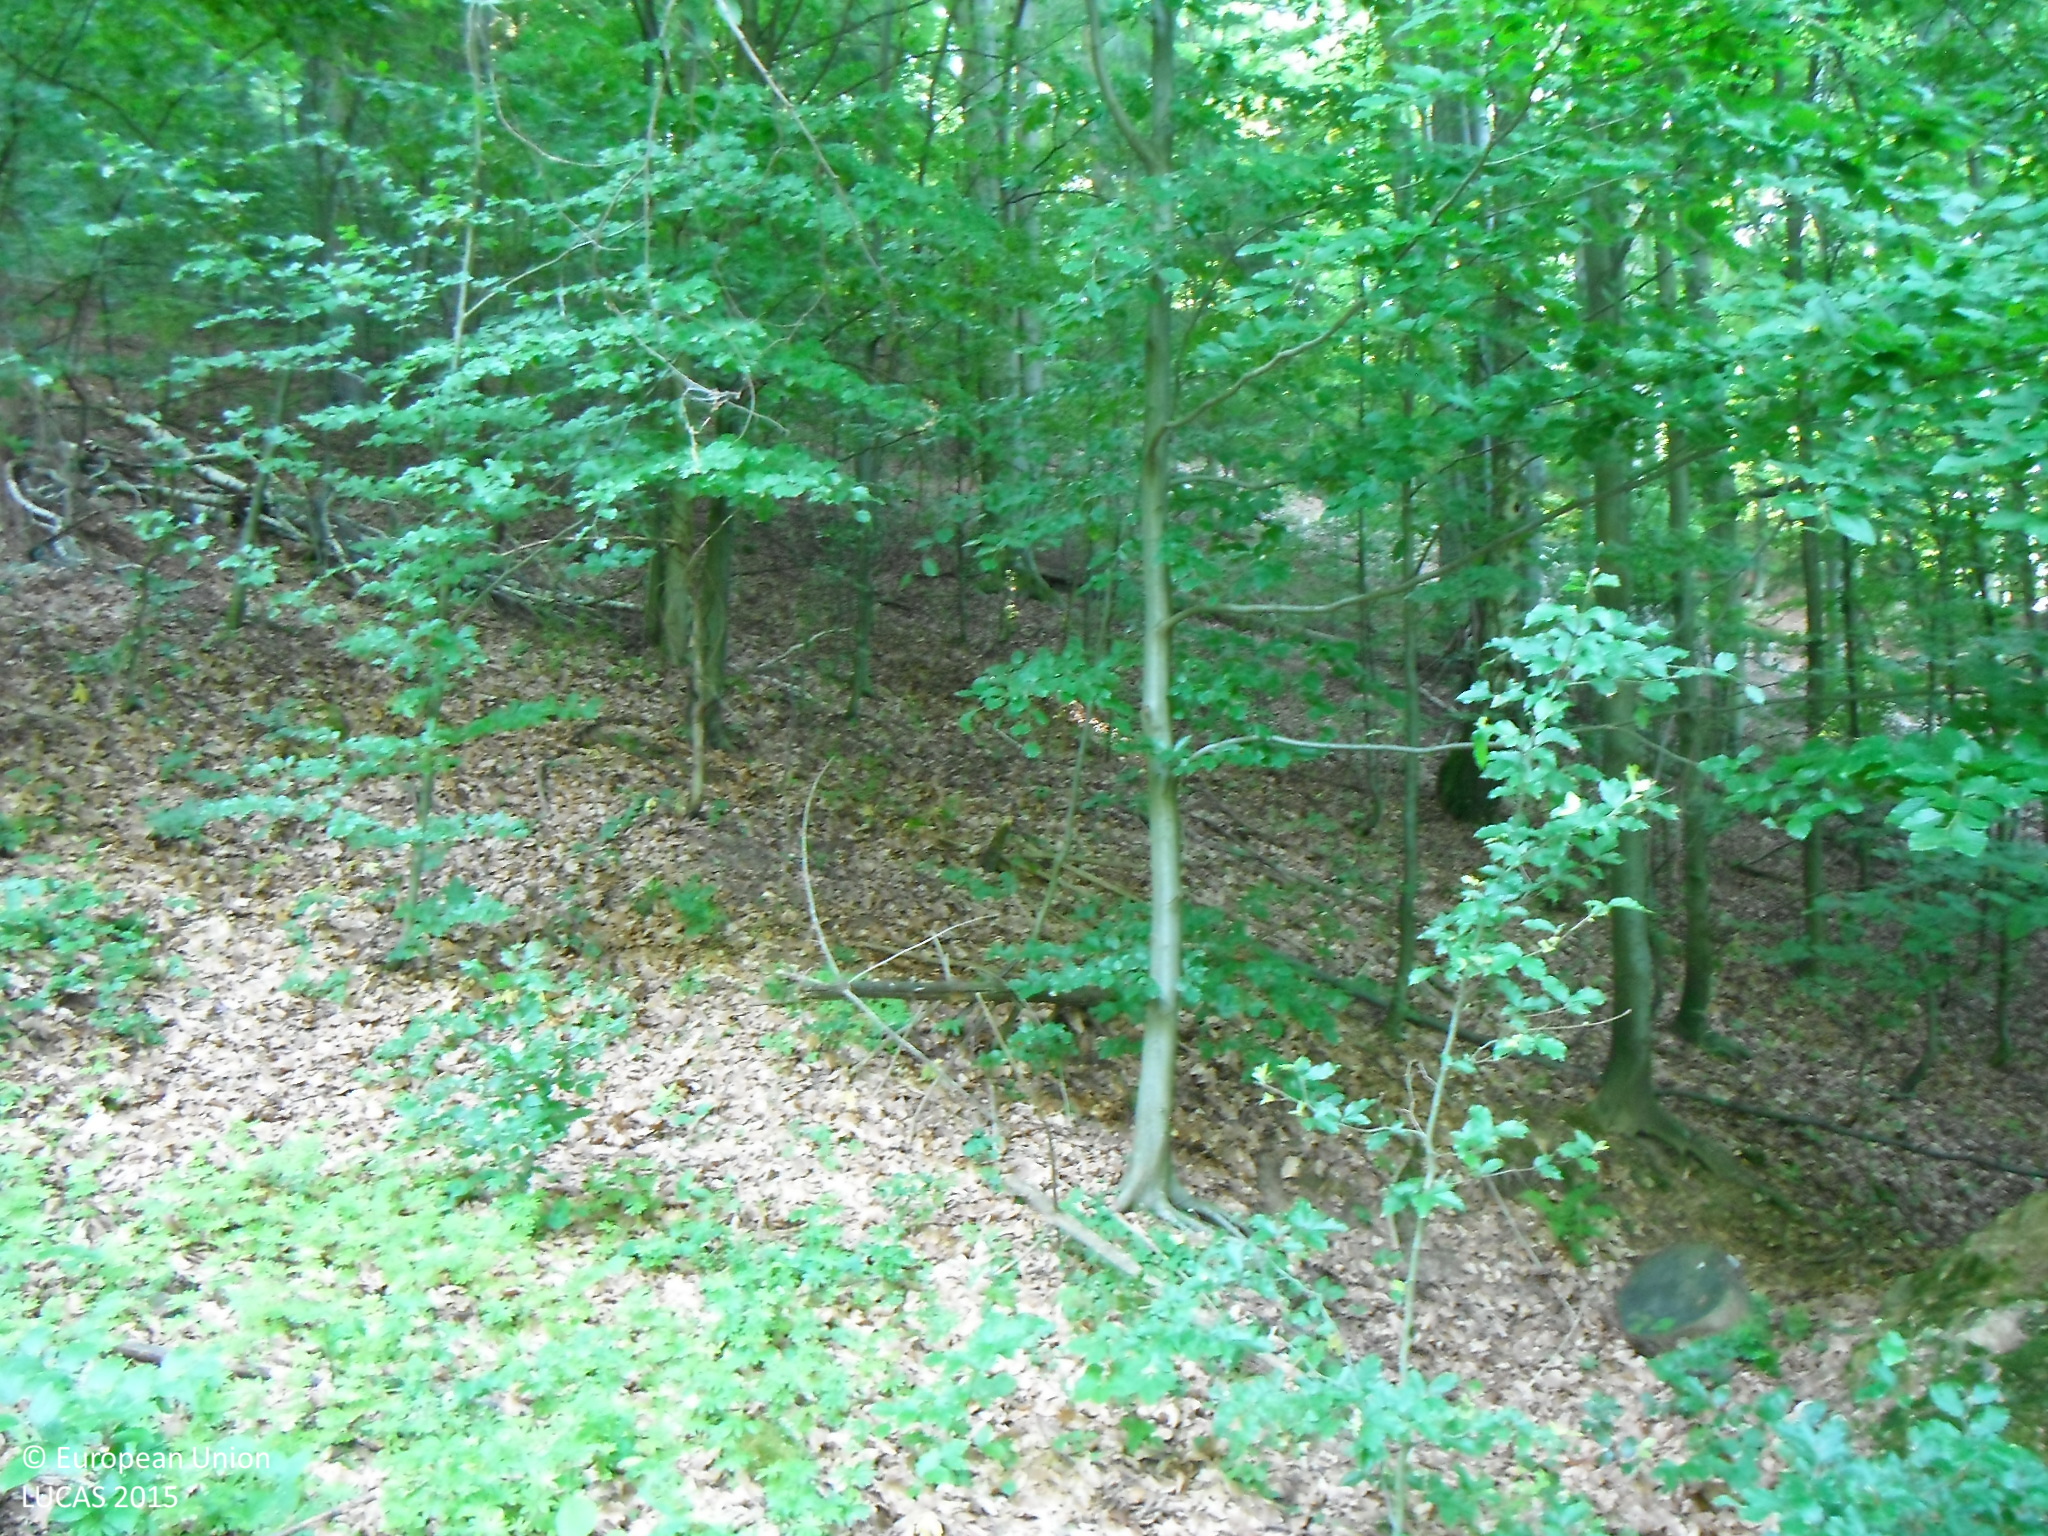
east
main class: Woodland
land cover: Broadleaved woodland
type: beech forest
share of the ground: > 75 %
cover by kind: broadleaved forest trees 80 %, herbaceous plants 10 %, coniferous forest trees 5 %, shrubs 5 %
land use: Forestry
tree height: > 5 m
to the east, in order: Broadleaved woodland; Spruce dominated mixed woodland; Tracks; Spruce dominated mixed woodland; Broadleaved woodland; Tracks; Broadleaved woodland; Tracks; Broadleaved woodland
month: June
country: SK
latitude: 48.5903
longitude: 19.7209
